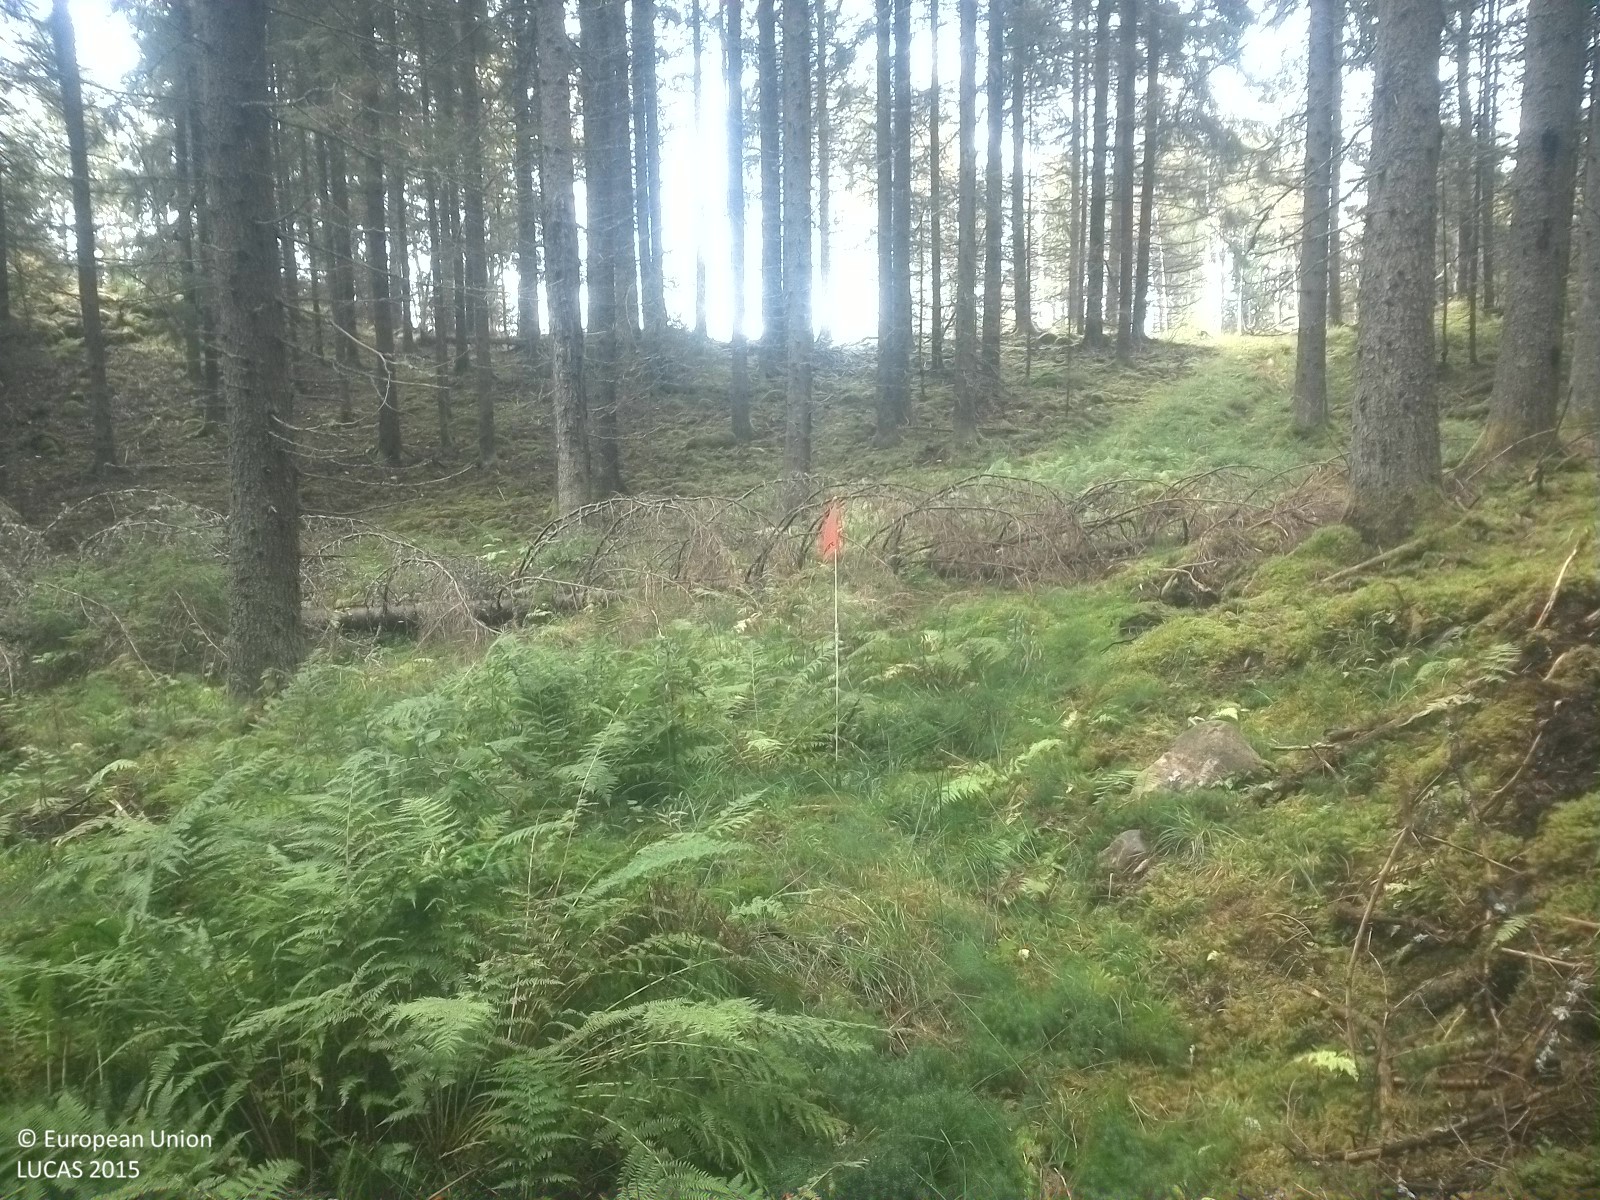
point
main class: Woodland
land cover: Spruce dominated coniferous woodland
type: boreal forest
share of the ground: 25 - 50 %
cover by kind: coniferous forest trees 40 %, lichens and mosses 30 %, herbaceous plants 25 %, broadleaved forest trees 5 %
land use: Forestry
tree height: > 5 m
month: September
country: SE
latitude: 58.7998
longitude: 15.7569
